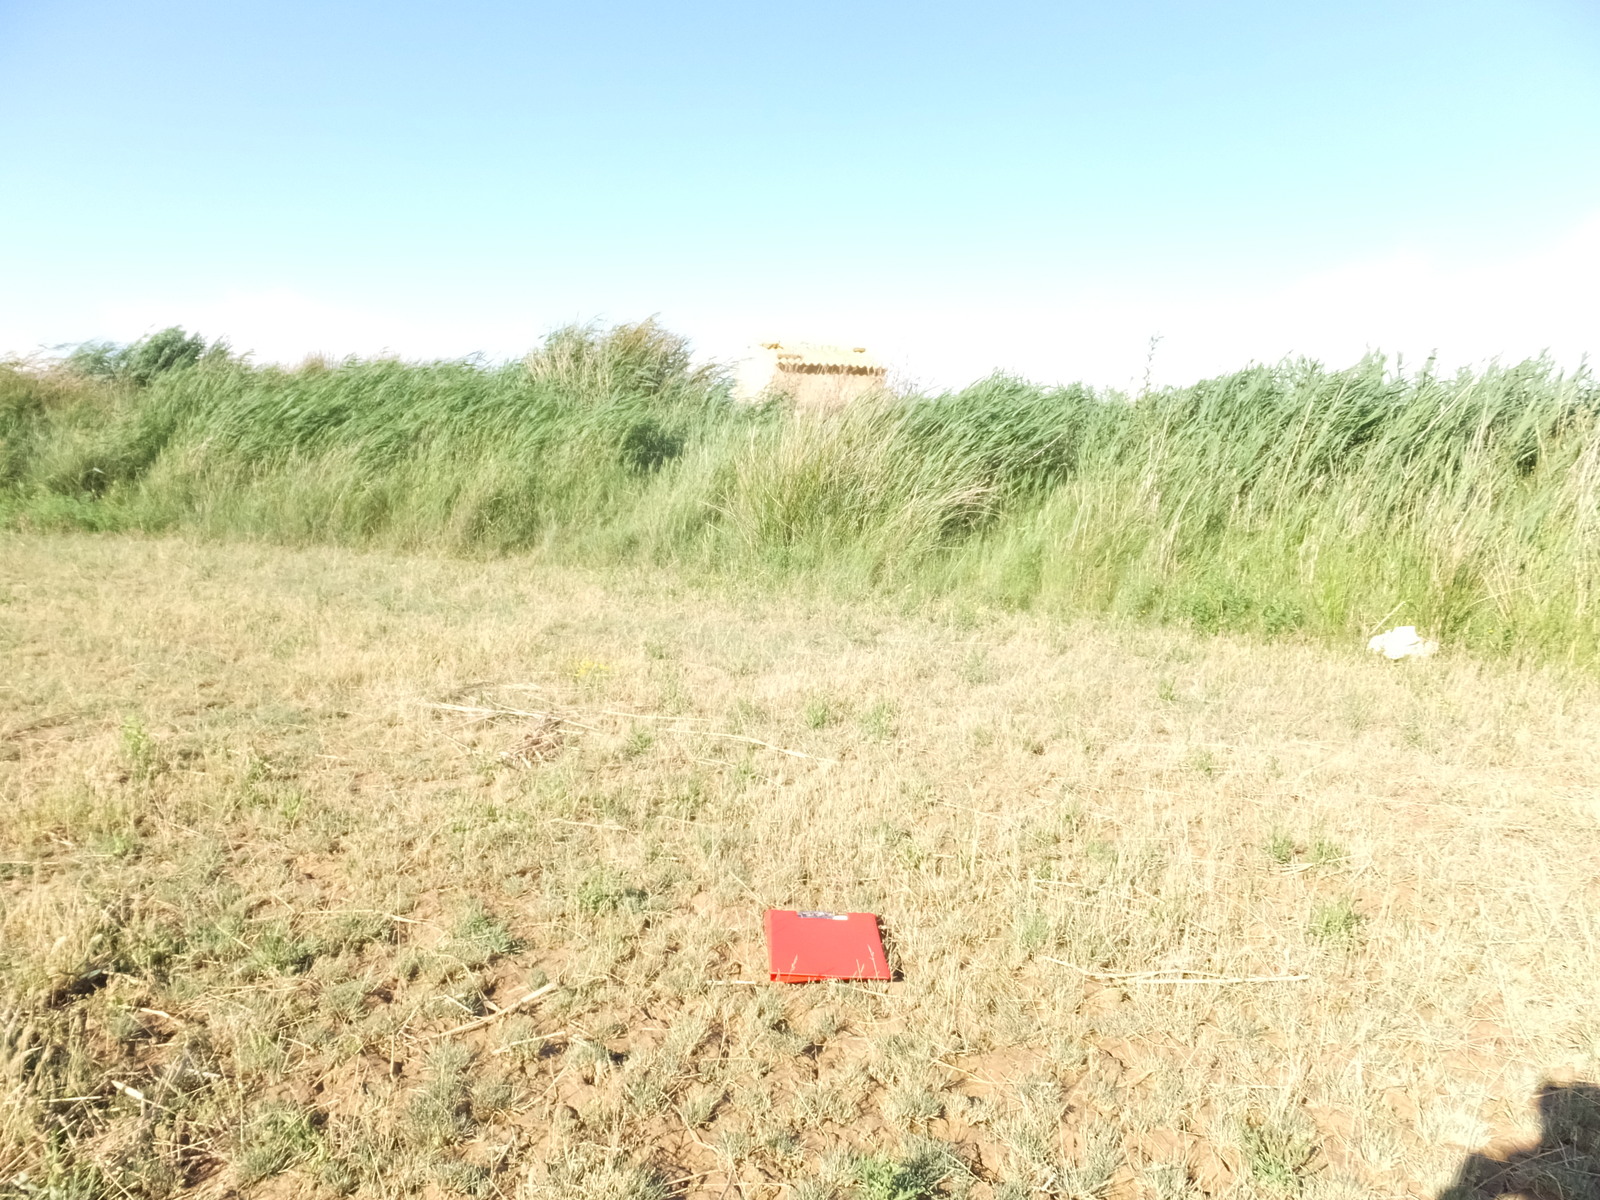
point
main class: Cropland
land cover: Lucerne
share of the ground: > 75 %
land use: Agriculture (excluding fallow land and kitchen gardens)
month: June
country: ES
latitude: 41.2136
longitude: -0.1630
